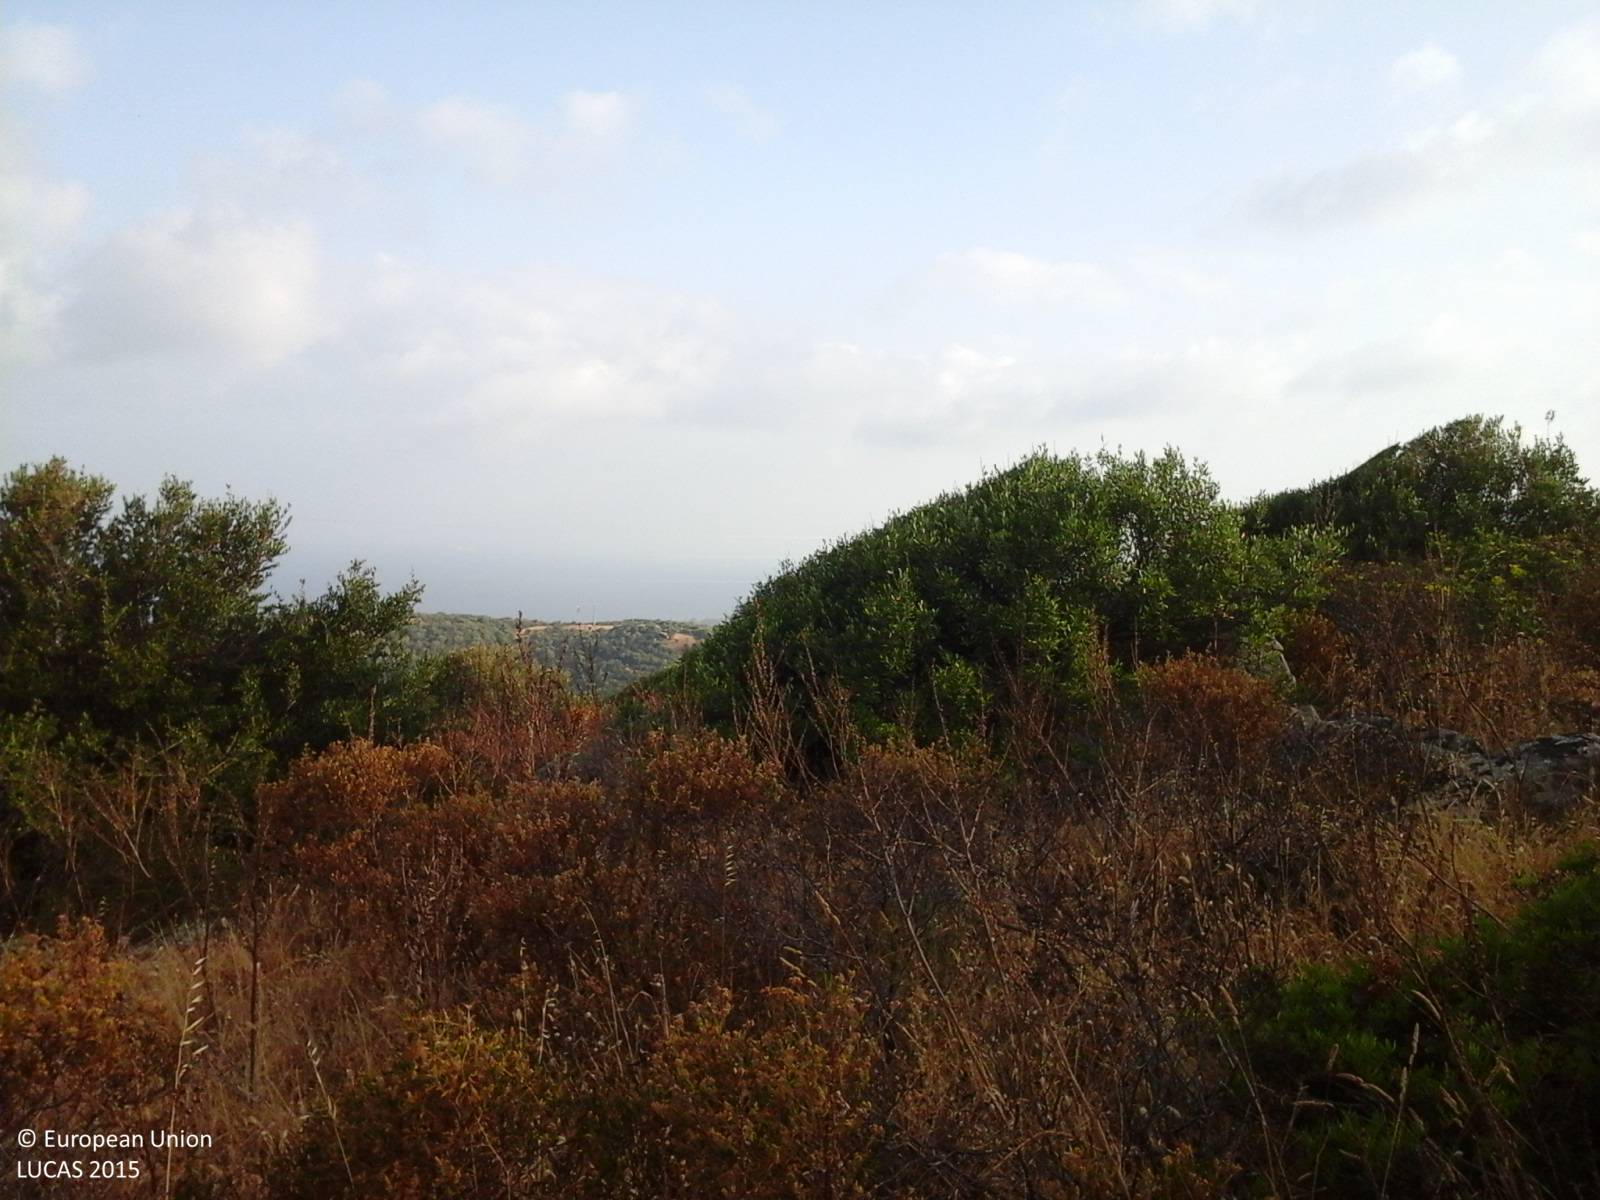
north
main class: Shrubland
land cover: Shrubland without tree cover
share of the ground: > 75 %
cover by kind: herbaceous plants 50 %, shrubs 40 %, consolidated bare surface 10 %
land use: Agriculture (excluding fallow land and kitchen gardens)
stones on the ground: < 10 %
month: June
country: IT
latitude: 40.9851
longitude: 8.8997
